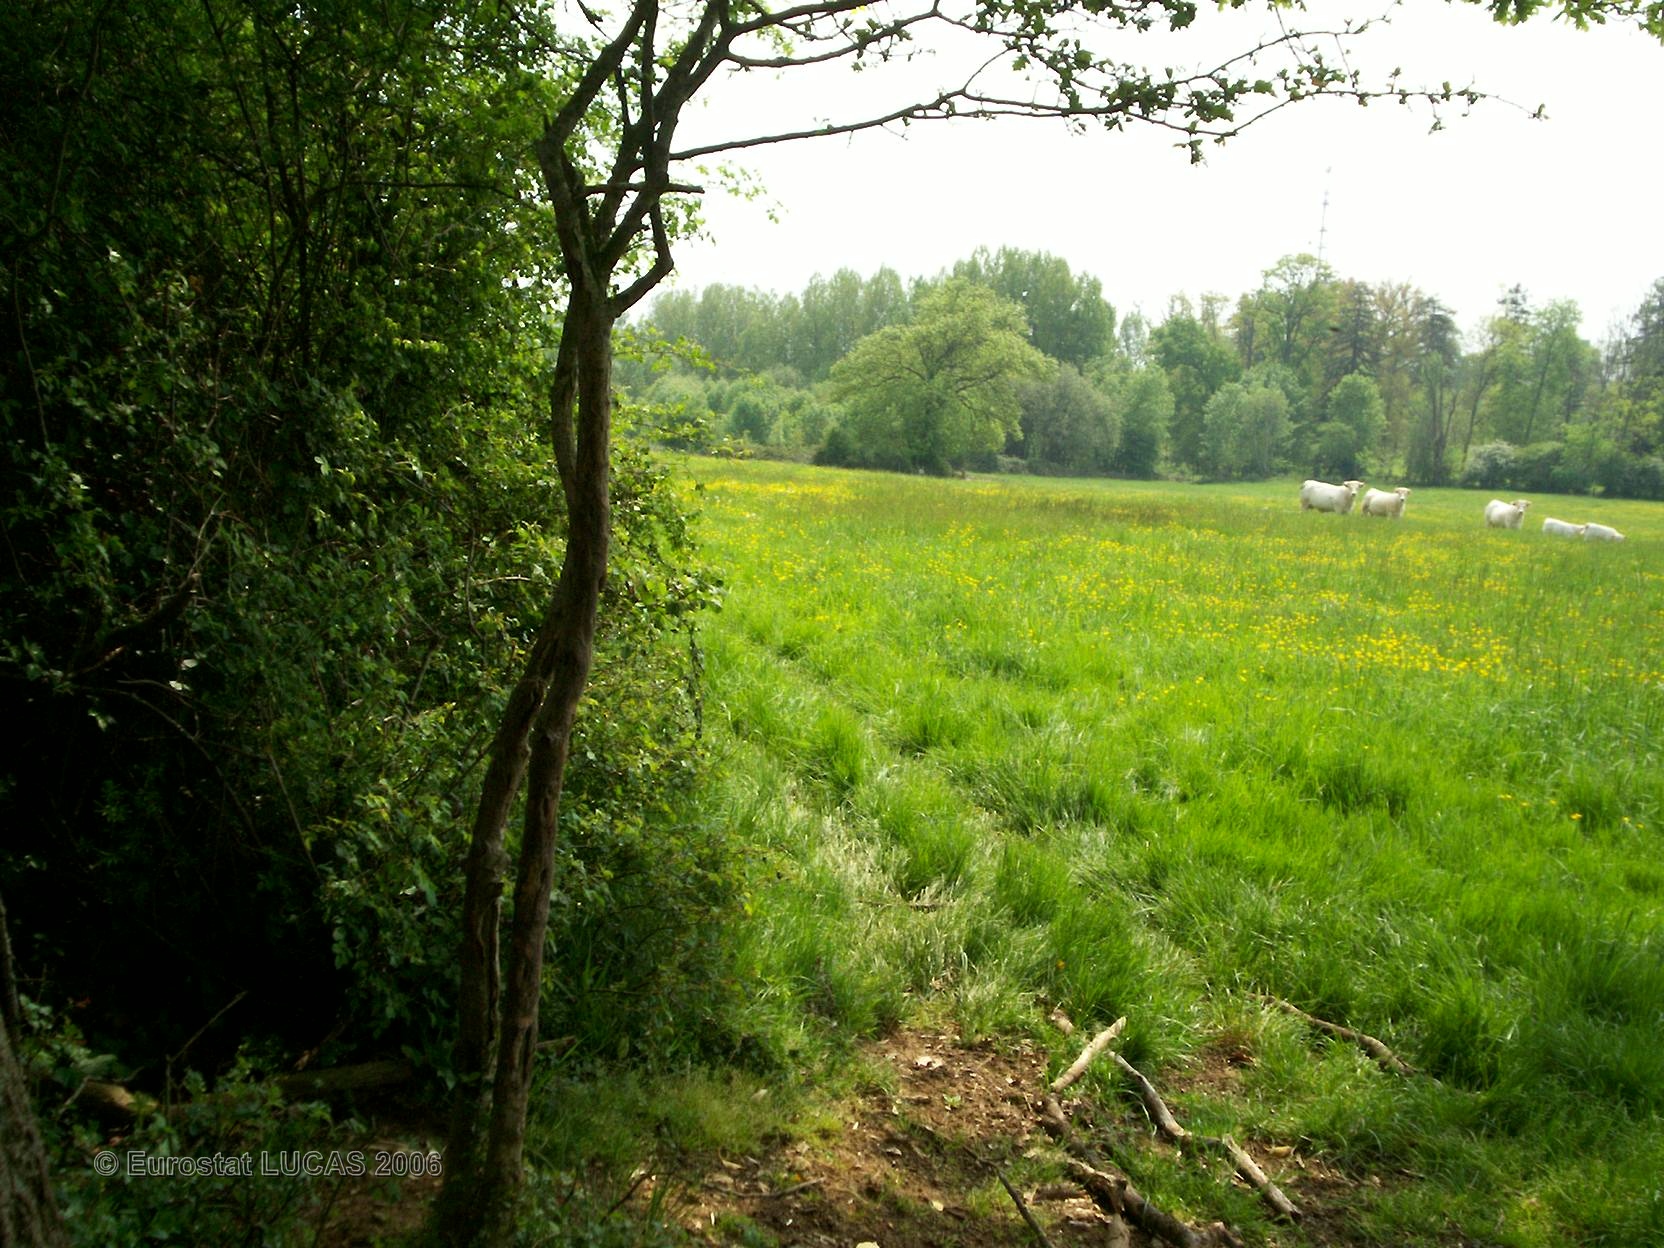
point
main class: Grassland
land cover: Grassland without tree/shrub cover
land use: Agriculture (excluding fallow land and kitchen gardens)
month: May
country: FR
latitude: 48.4644
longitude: 0.0852
